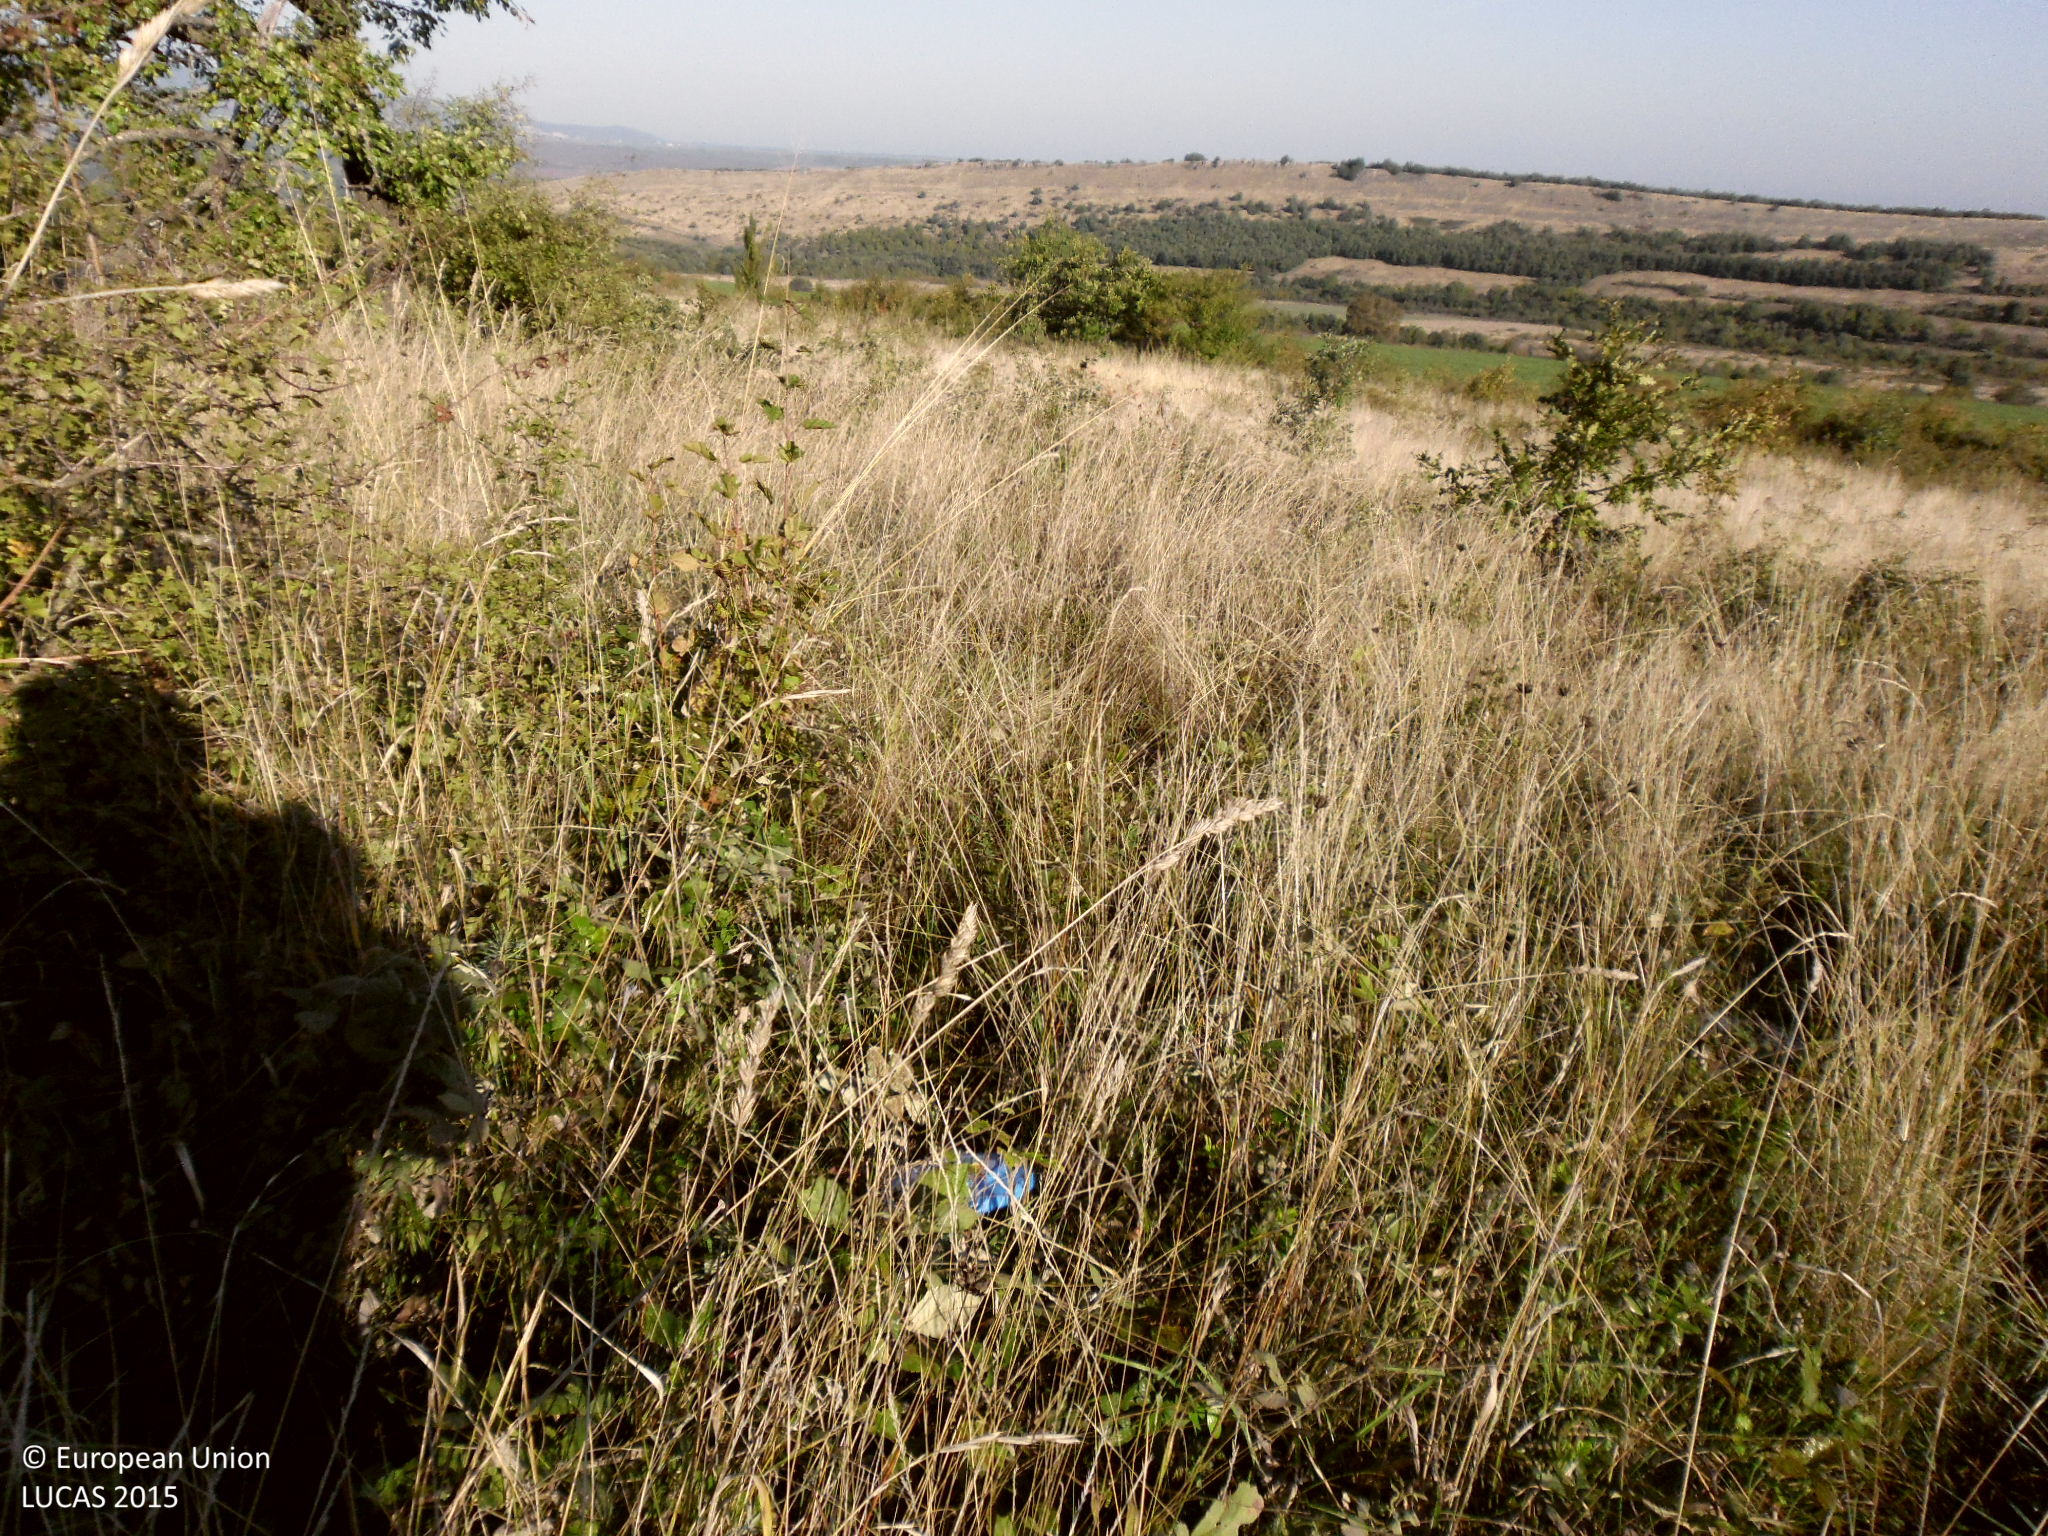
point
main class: Grassland
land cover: Grassland with sparse tree/shrub cover
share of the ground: > 75 %
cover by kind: herbaceous plants 90 %, broadleaved forest trees 5 %, shrubs 5 %
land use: Semi-natural and natural areas not in use
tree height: < 5 m
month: October
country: BG
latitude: 43.5839
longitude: 22.8540
